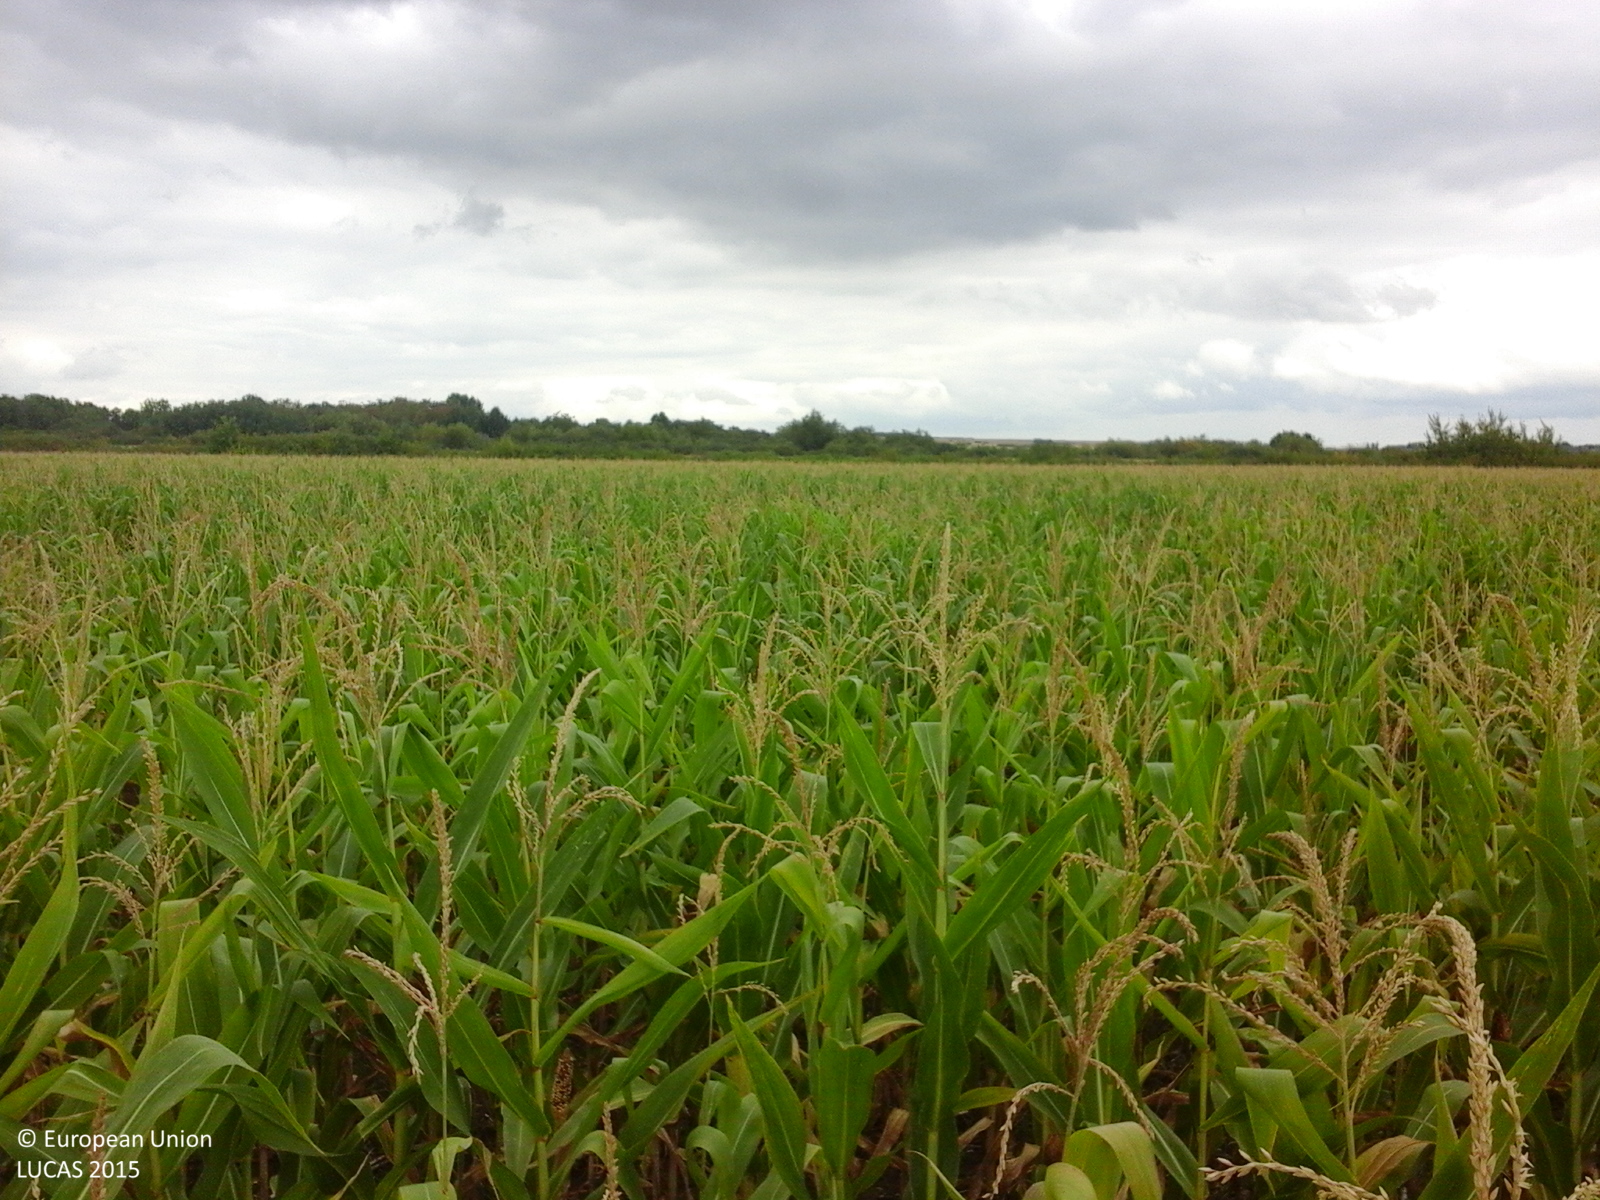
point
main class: Cropland
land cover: Maize
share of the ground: > 75 %
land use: Agriculture (excluding fallow land and kitchen gardens)
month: August
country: RO
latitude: 45.4378
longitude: 21.4988
